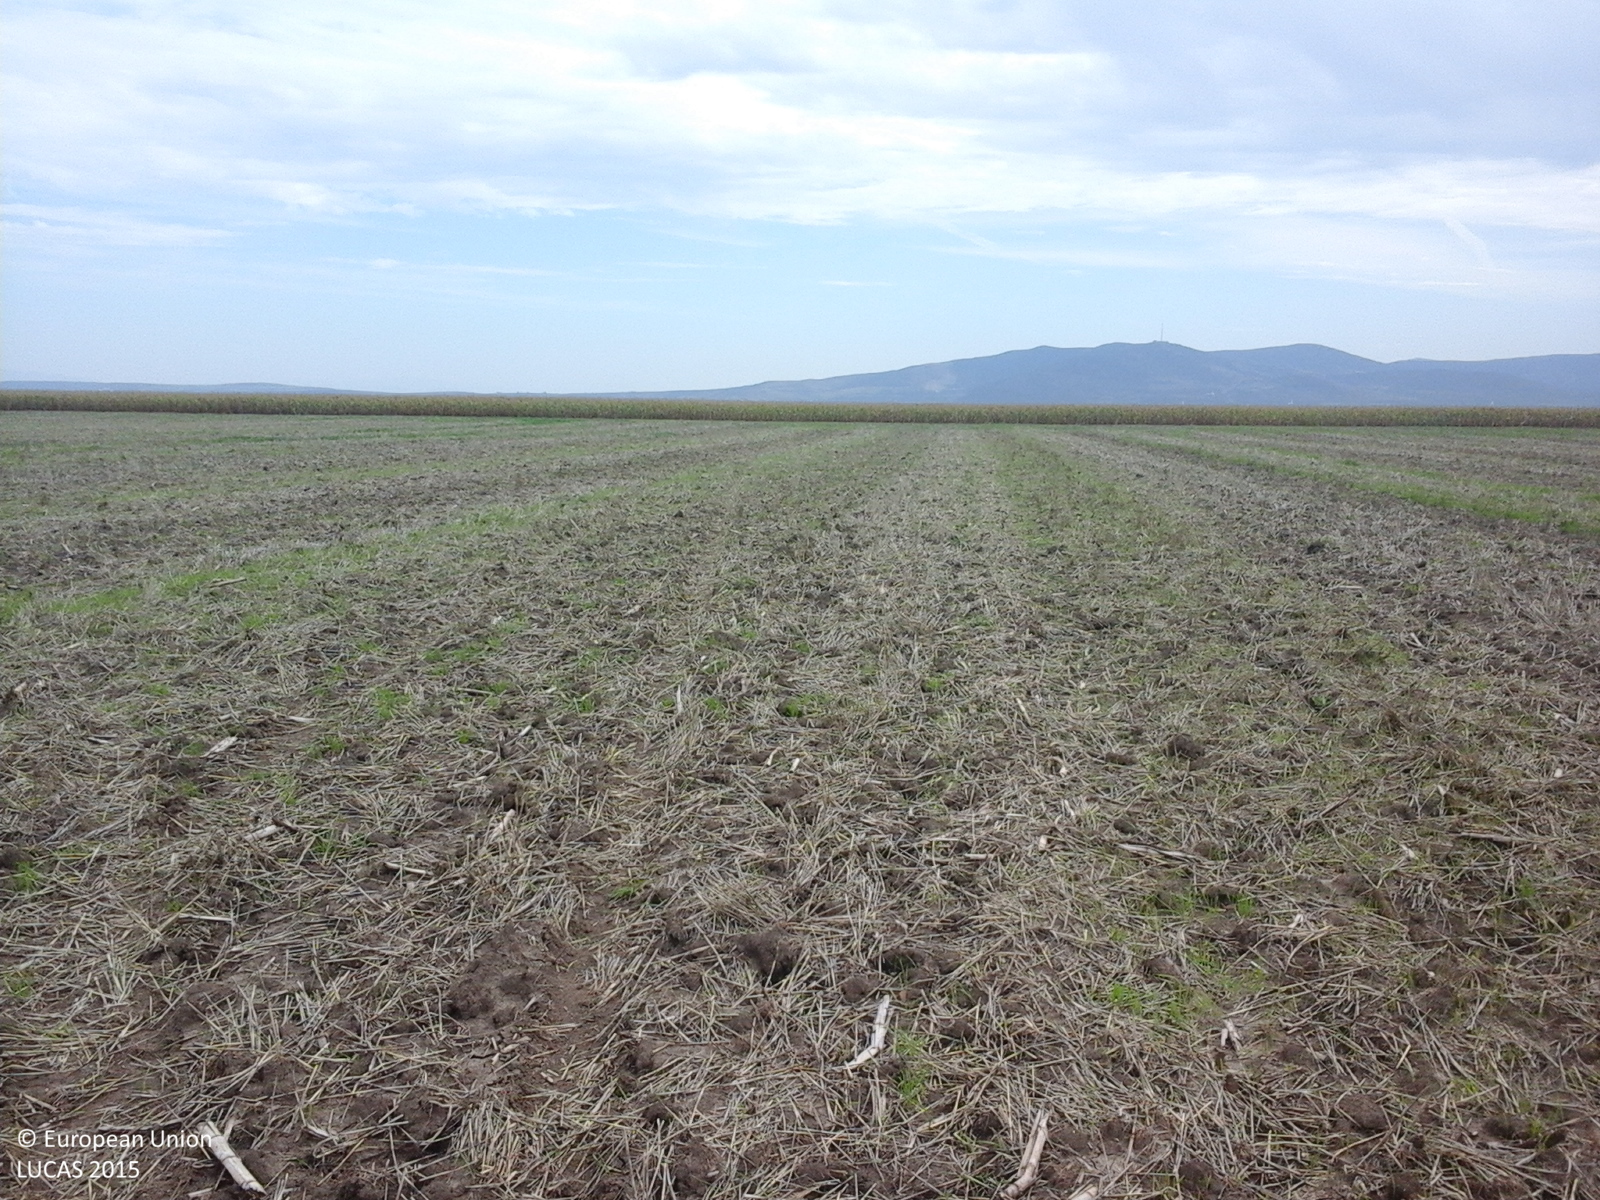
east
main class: Cropland
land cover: Common wheat
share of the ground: 25 - 50 %
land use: Agriculture (excluding fallow land and kitchen gardens)
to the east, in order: Common wheat; Tracks; Maize
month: August
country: RO
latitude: 46.2870
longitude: 21.5503
